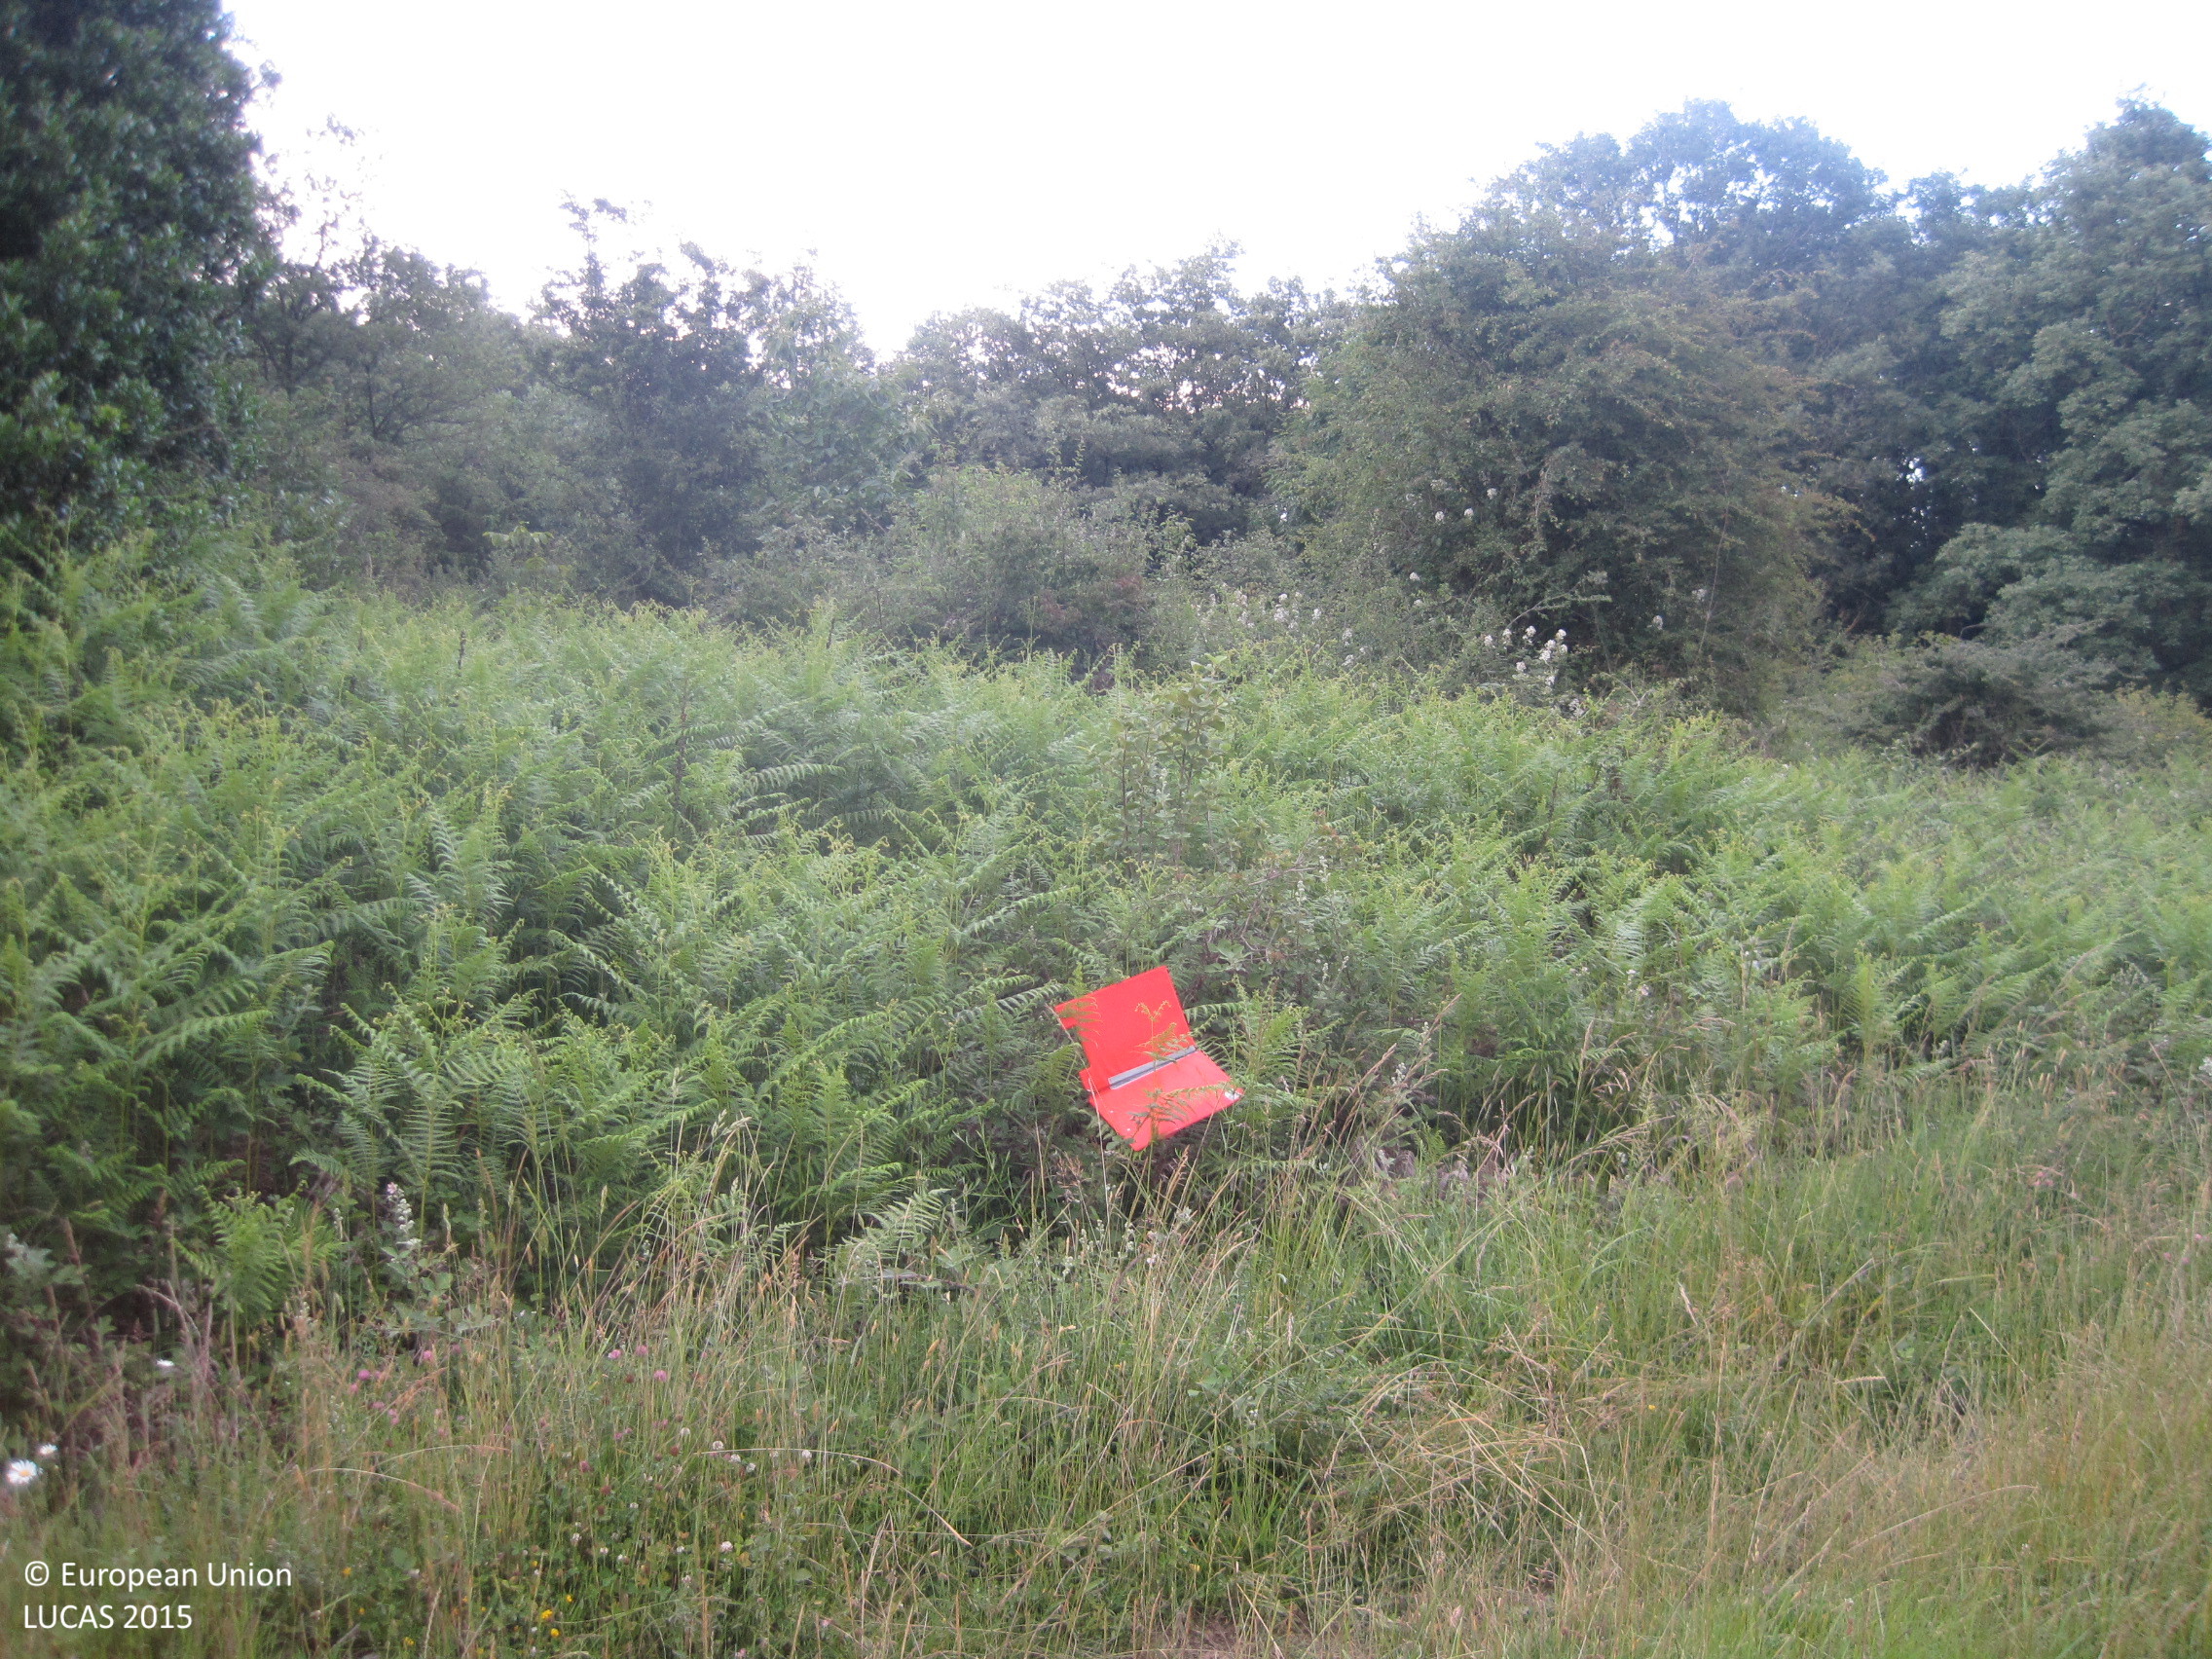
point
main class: Shrubland
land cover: Shrubland without tree cover
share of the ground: 10 - 25 %
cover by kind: herbaceous plants 80 %, shrubs 20 %
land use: Semi-natural and natural areas not in use
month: June
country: ES
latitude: 42.9728
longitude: -1.7264
